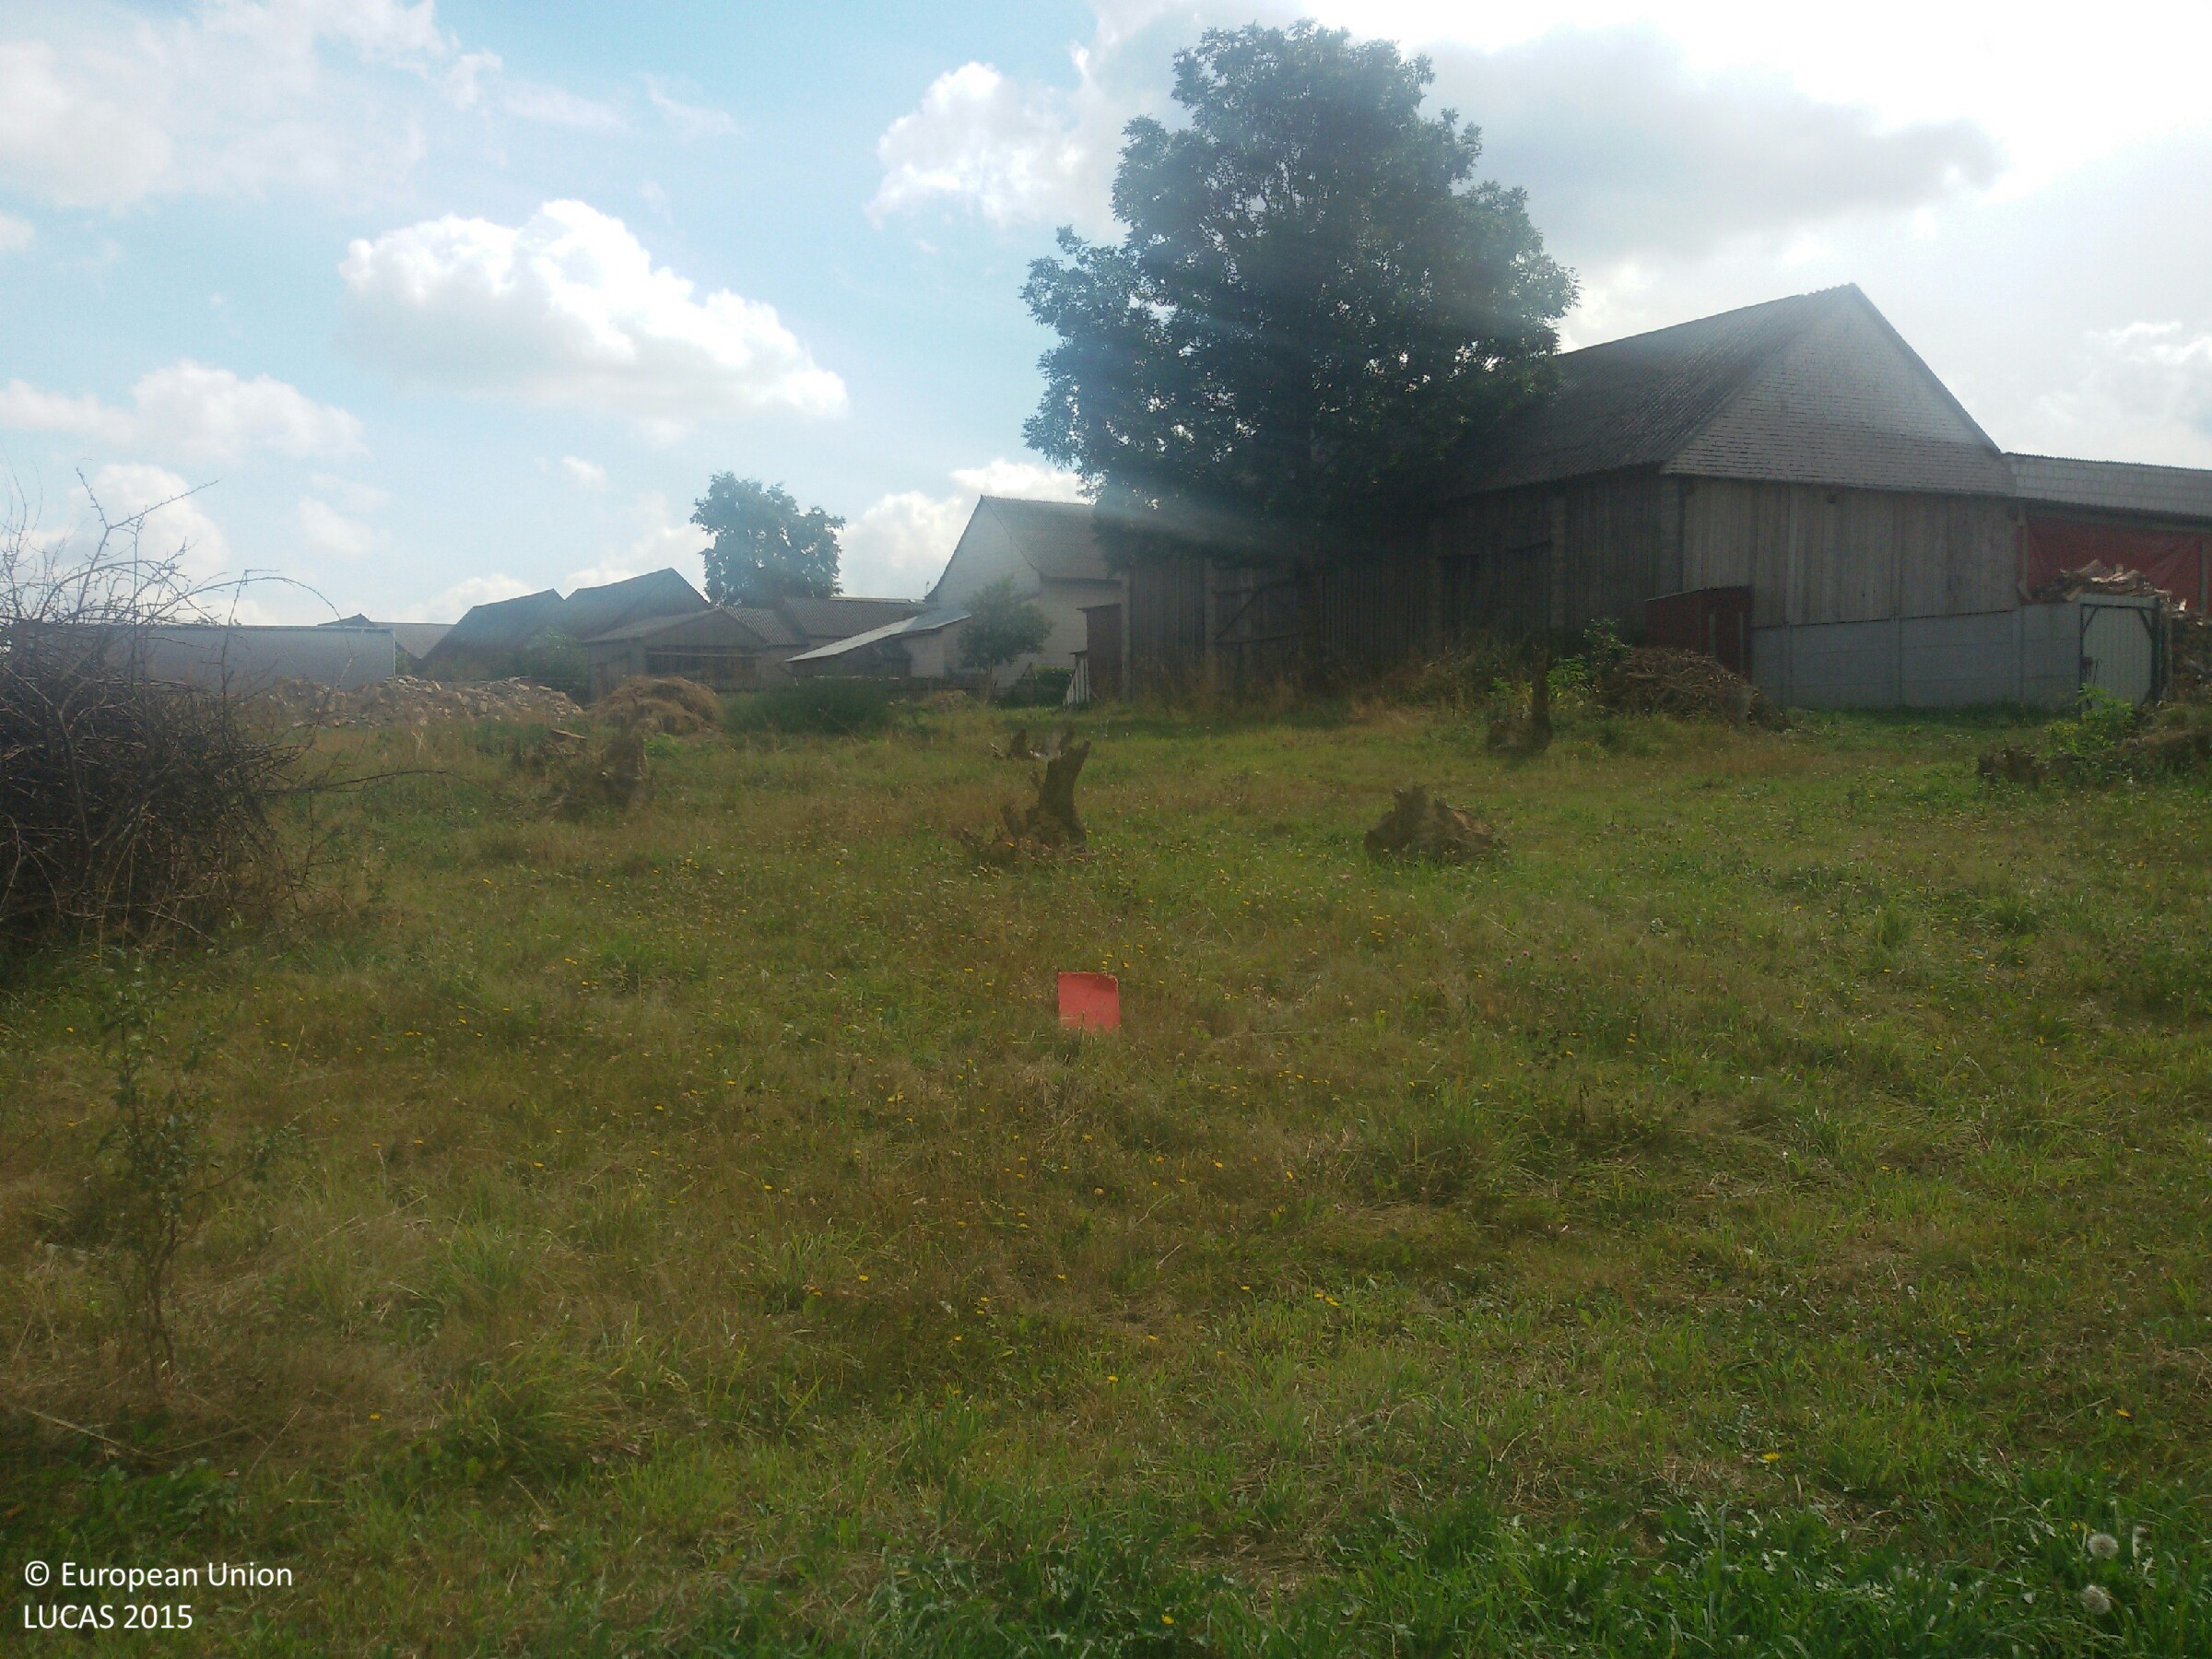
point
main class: Grassland
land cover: Grassland without tree/shrub cover
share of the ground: > 75 %
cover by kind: herbaceous plants 100 %
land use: Agriculture (excluding fallow land and kitchen gardens)
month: September
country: PL
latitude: 50.9632
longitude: 20.9359
